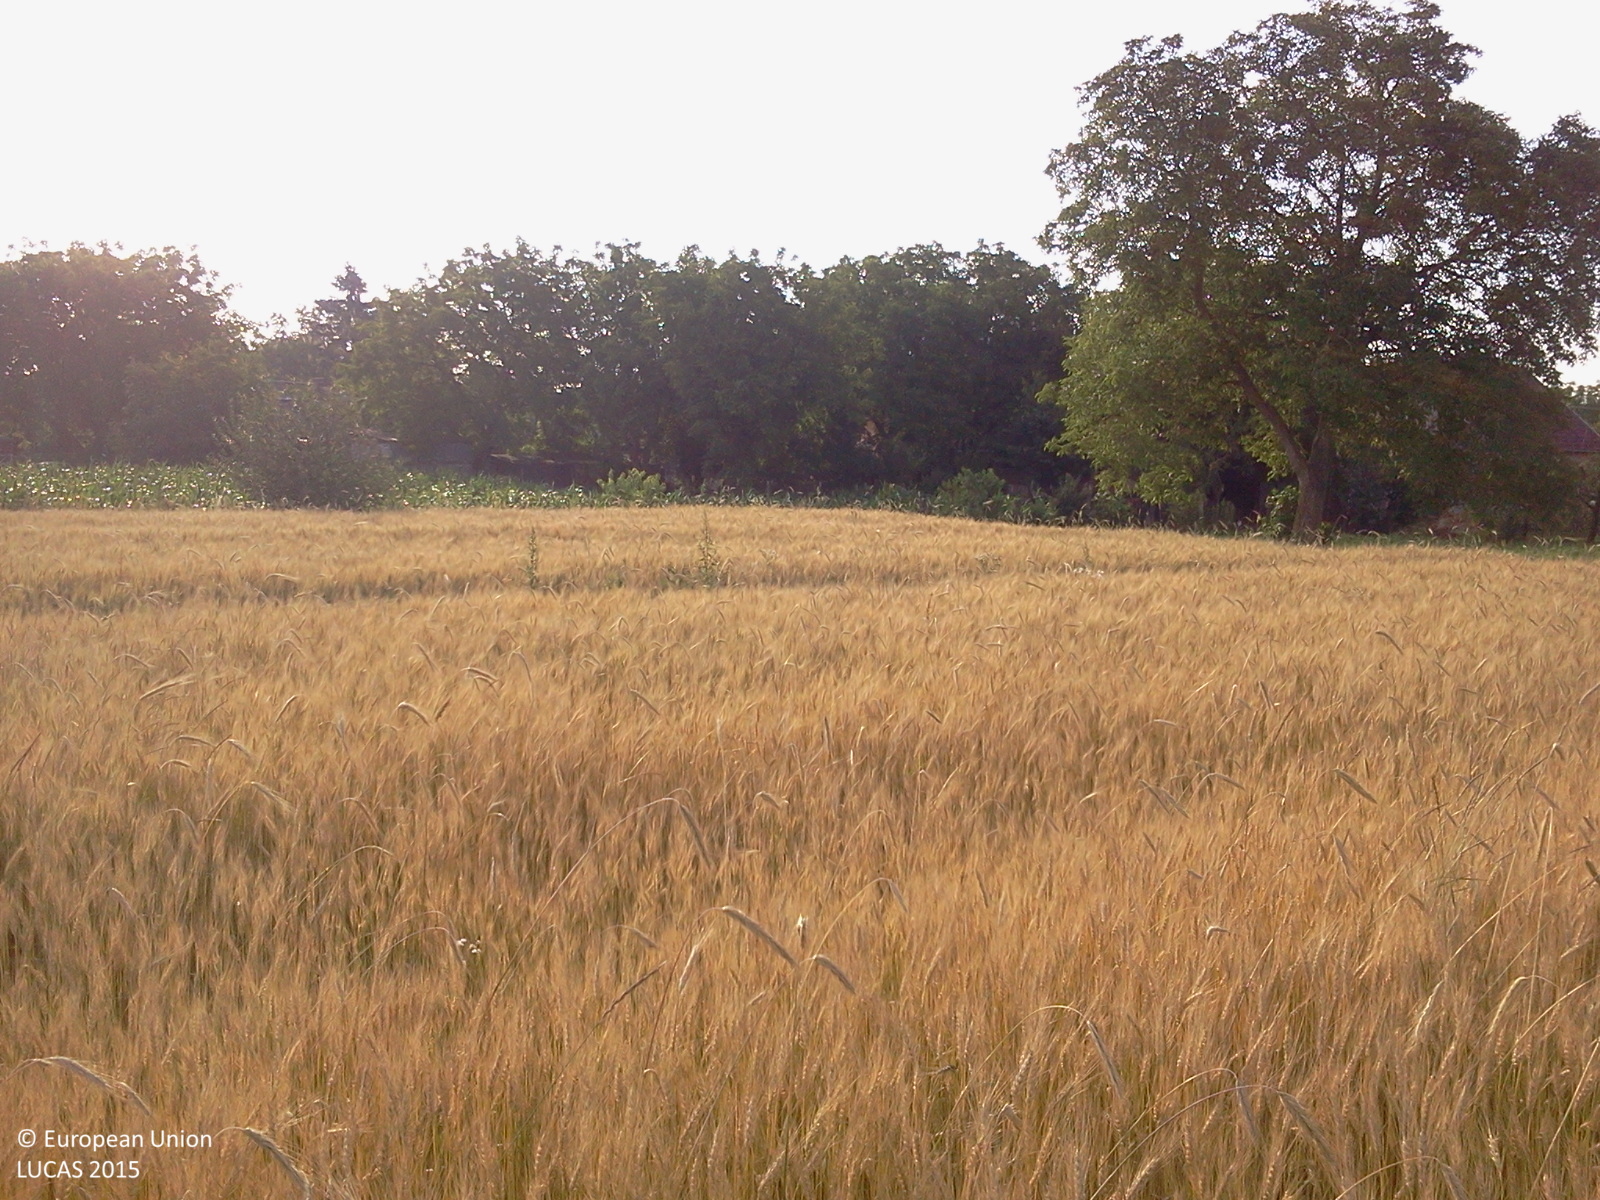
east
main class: Cropland
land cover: Durum wheat
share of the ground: > 75 %
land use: Agriculture (excluding fallow land and kitchen gardens)
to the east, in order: Durum wheat; Maize; Artificial constructions in urban areas; Broadleaved woodland
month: June
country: HU
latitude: 46.7180
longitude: 17.0027
